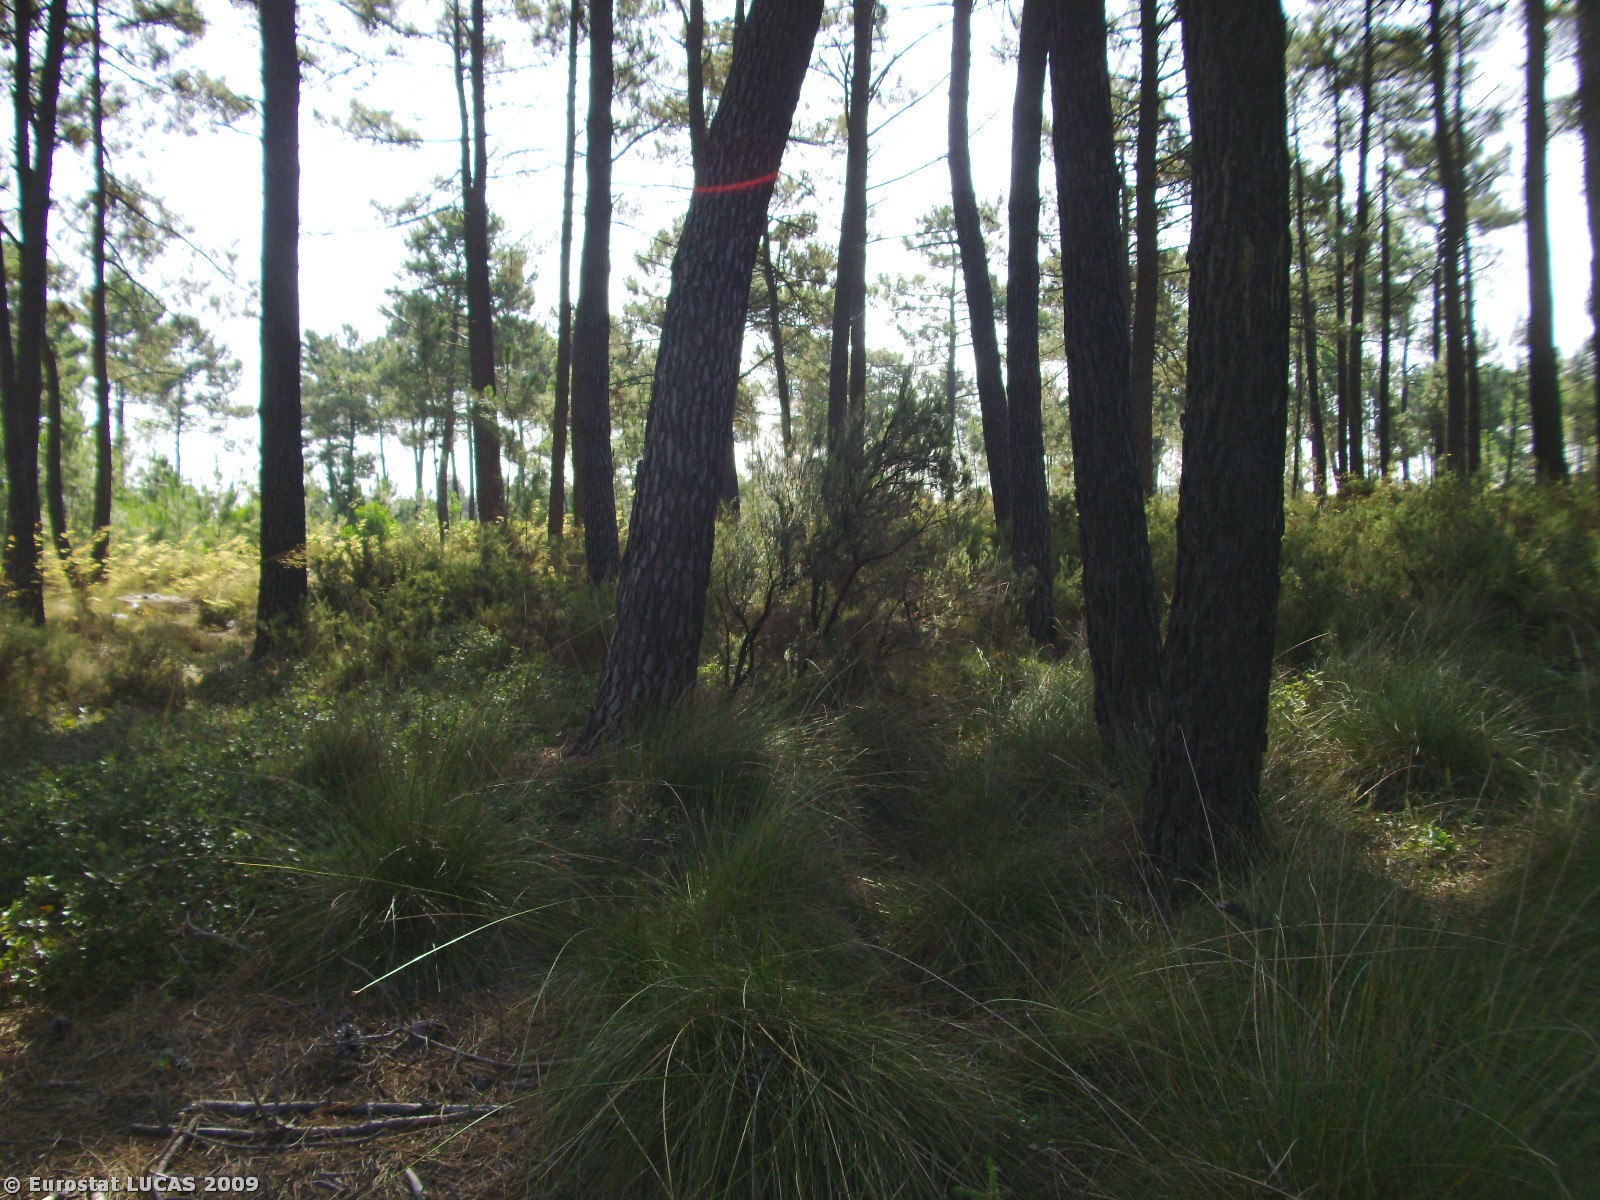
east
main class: Woodland
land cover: Coniferous woodland
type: coniferous forest of the mediterranean region
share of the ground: 10 - 25 %
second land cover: Spontaneously vegetated surfaces
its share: 50 - 75 %
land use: Forestry
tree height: > 5 m
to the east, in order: Coniferous woodland; Spontaneously vegetated surfaces; Coniferous woodland; Tracks; Shrubland with sparse tree cover; Fences; Bare land; Vineyards; Oranges; Fences; Electric lines; Tracks
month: July
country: PT
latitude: 38.5722
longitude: -9.1131
